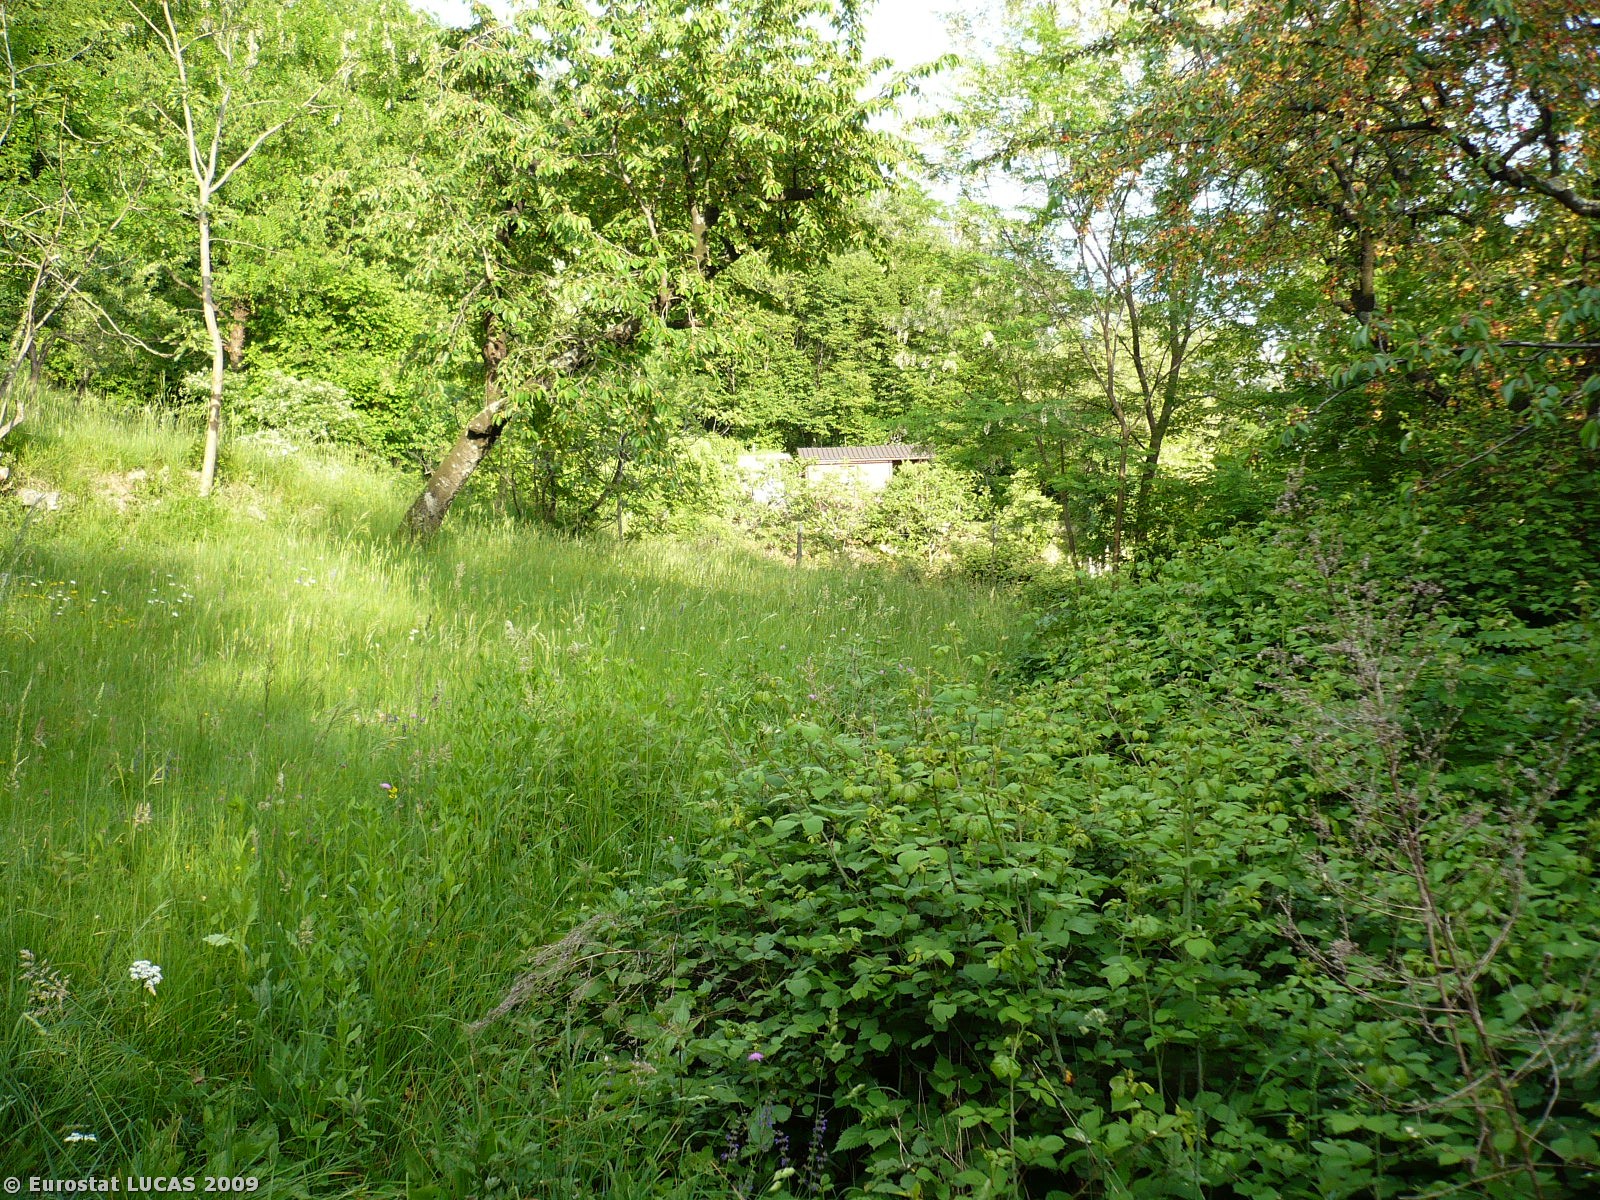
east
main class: Shrubland
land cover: Shrubland with sparse tree cover
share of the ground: 25 - 50 %
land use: Unused
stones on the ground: < 10 %
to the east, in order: Shrubland with sparse tree cover; Grassland with sparse tree/shrub cover; Dry stone walls; Abandoned hedges; Grassland with sparse tree/shrub cover; Abandoned hedges; Grassland with sparse tree/shrub cover; Broadleaved woodland; Shrubland without tree cover; Fences; Grassland without tree/shrub cover; Shrubland with sparse tree cover; Fences; Electric lines; Paved roads, cycling and walking lanes; Grassland without tree/shrub cover; Broadleaved woodland; Artificial constructions in urban areas; Grassland with sparse tree/shrub cover; Vineyards
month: May
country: SI
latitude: 45.9636
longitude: 13.6738
